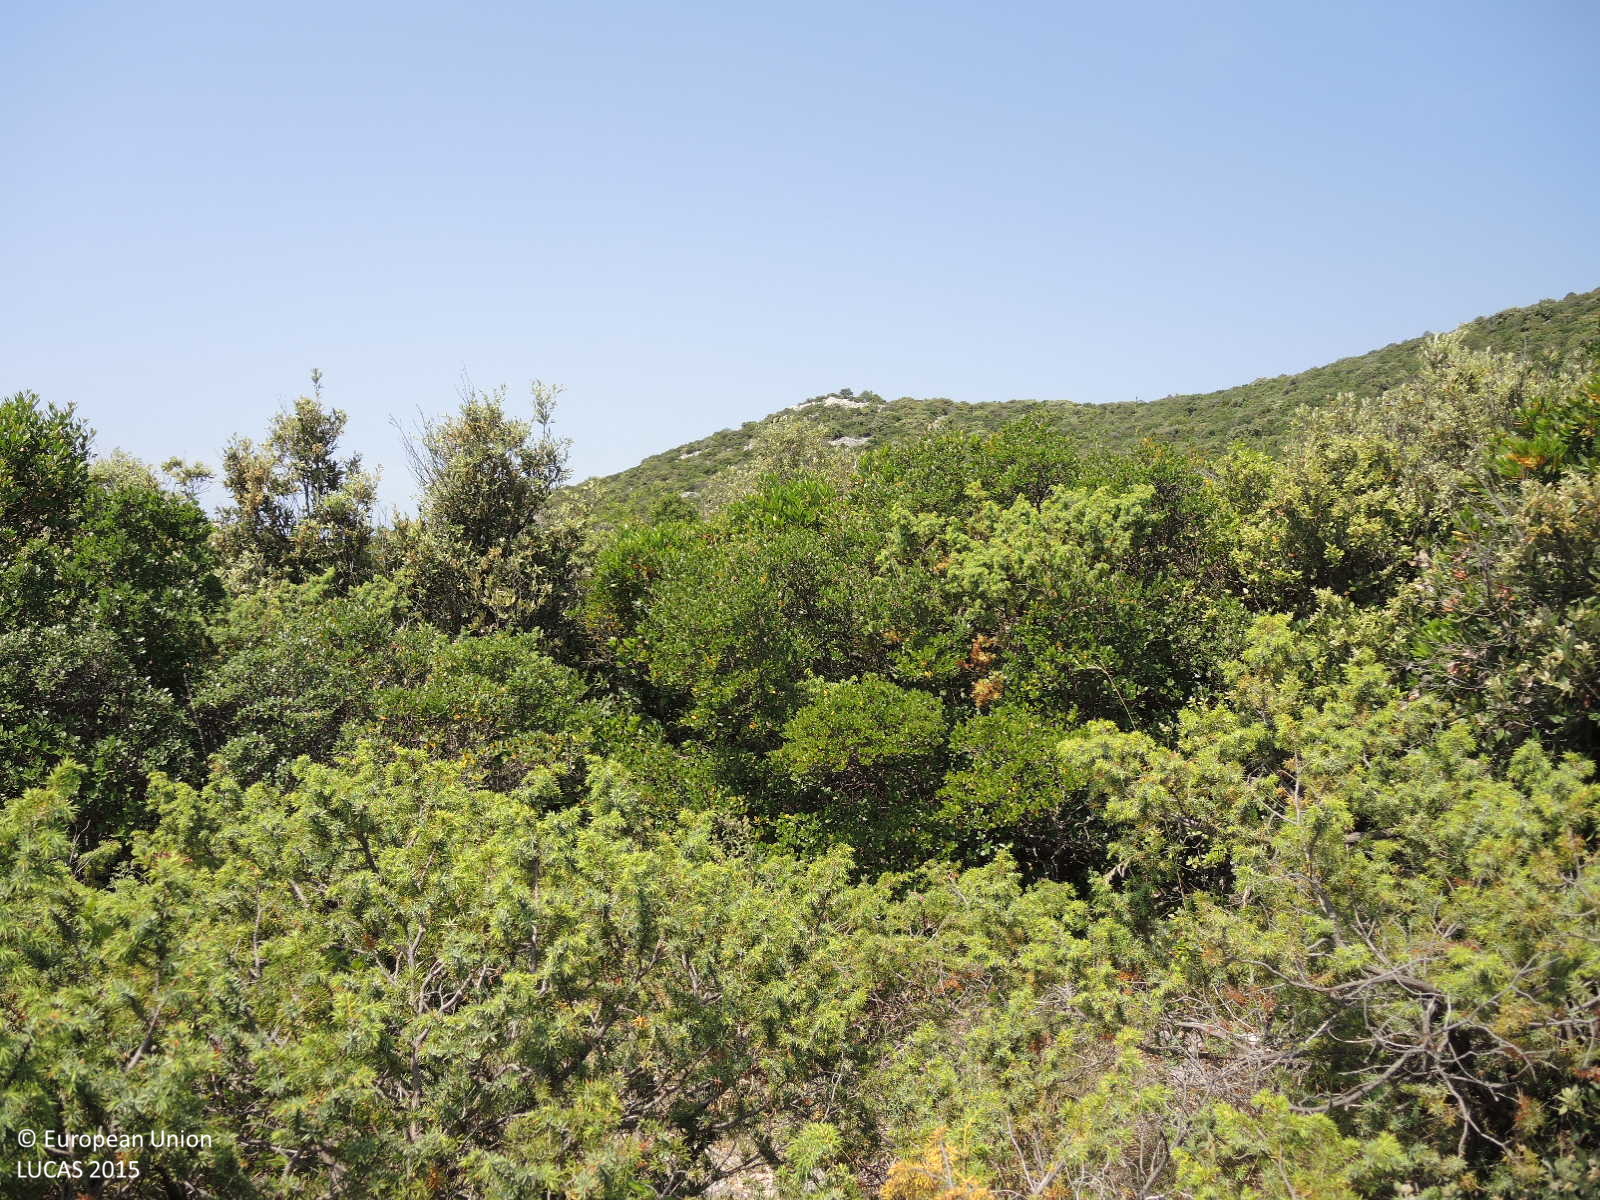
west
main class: Shrubland
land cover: Shrubland without tree cover
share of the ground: > 75 %
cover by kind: shrubs 70 %, herbaceous plants 20 %, unconsolidated bare surface 10 %
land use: Semi-natural and natural areas not in use
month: May
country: HR
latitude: 43.8503
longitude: 15.7011
